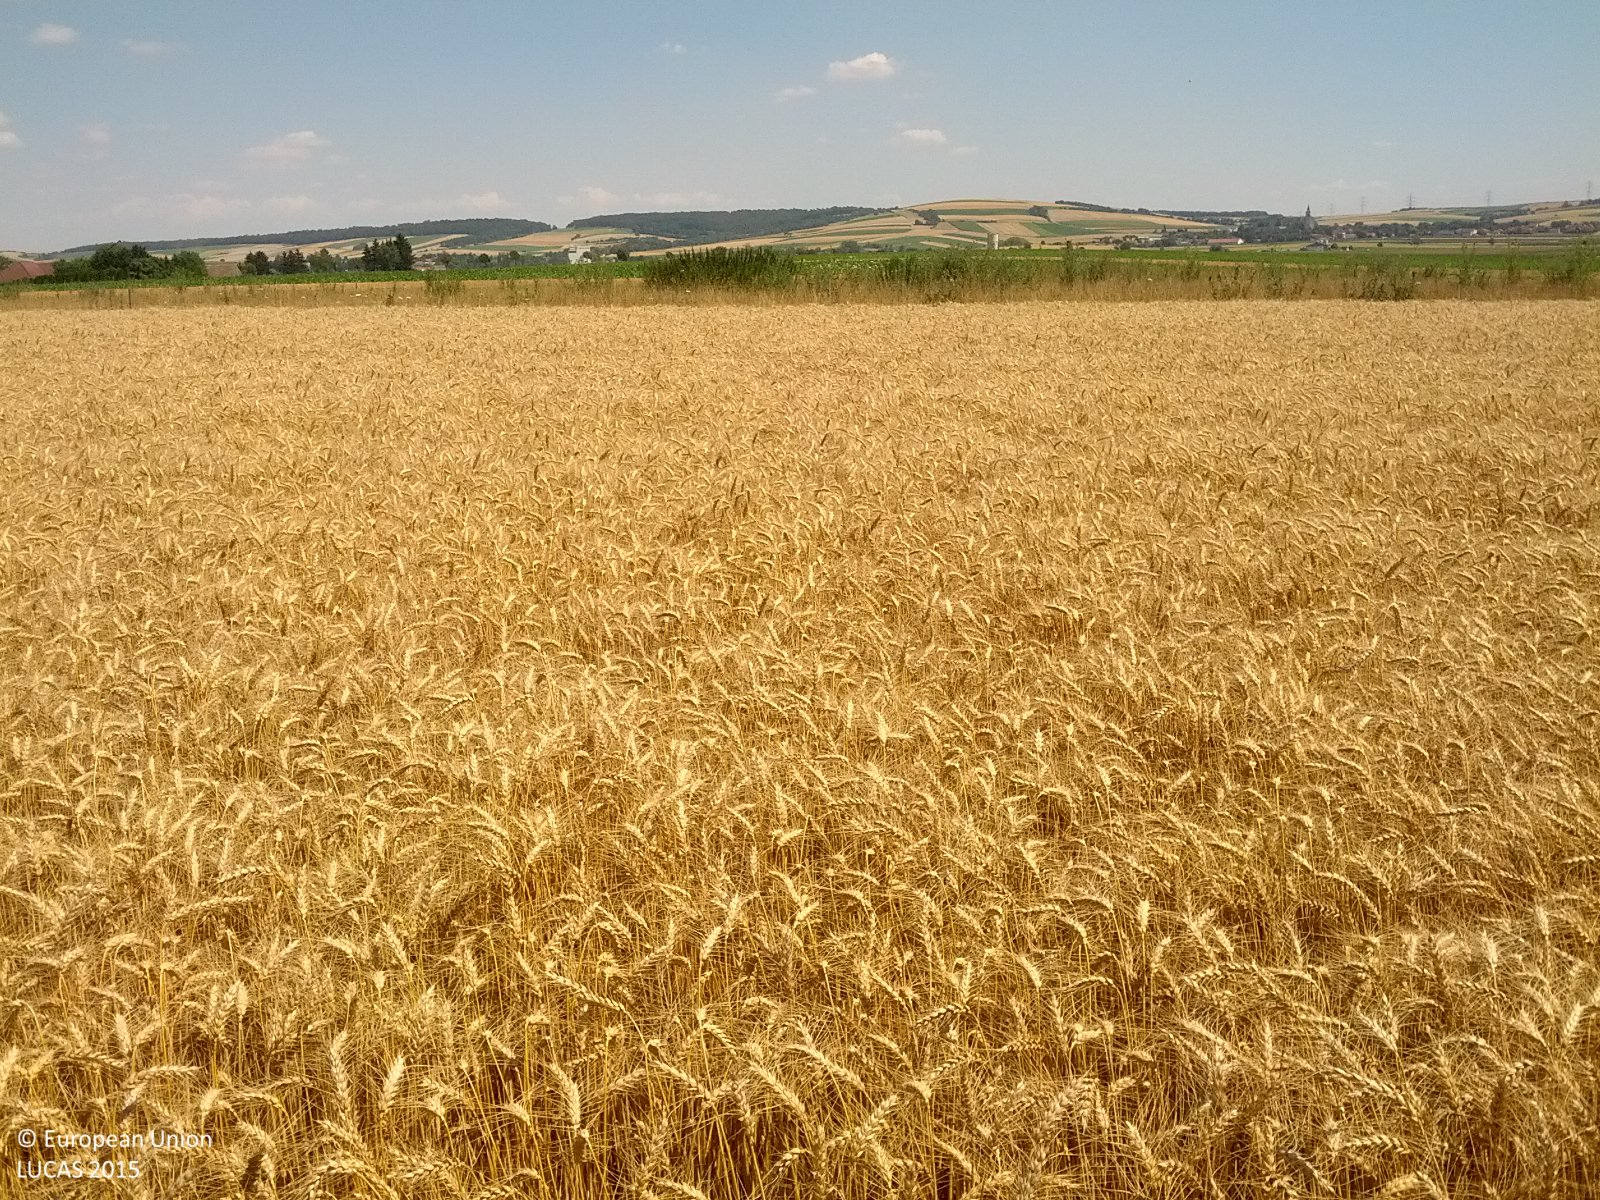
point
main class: Cropland
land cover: Common wheat
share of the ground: > 75 %
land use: Agriculture (excluding fallow land and kitchen gardens)
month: July
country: AT
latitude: 48.4603
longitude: 16.2663
